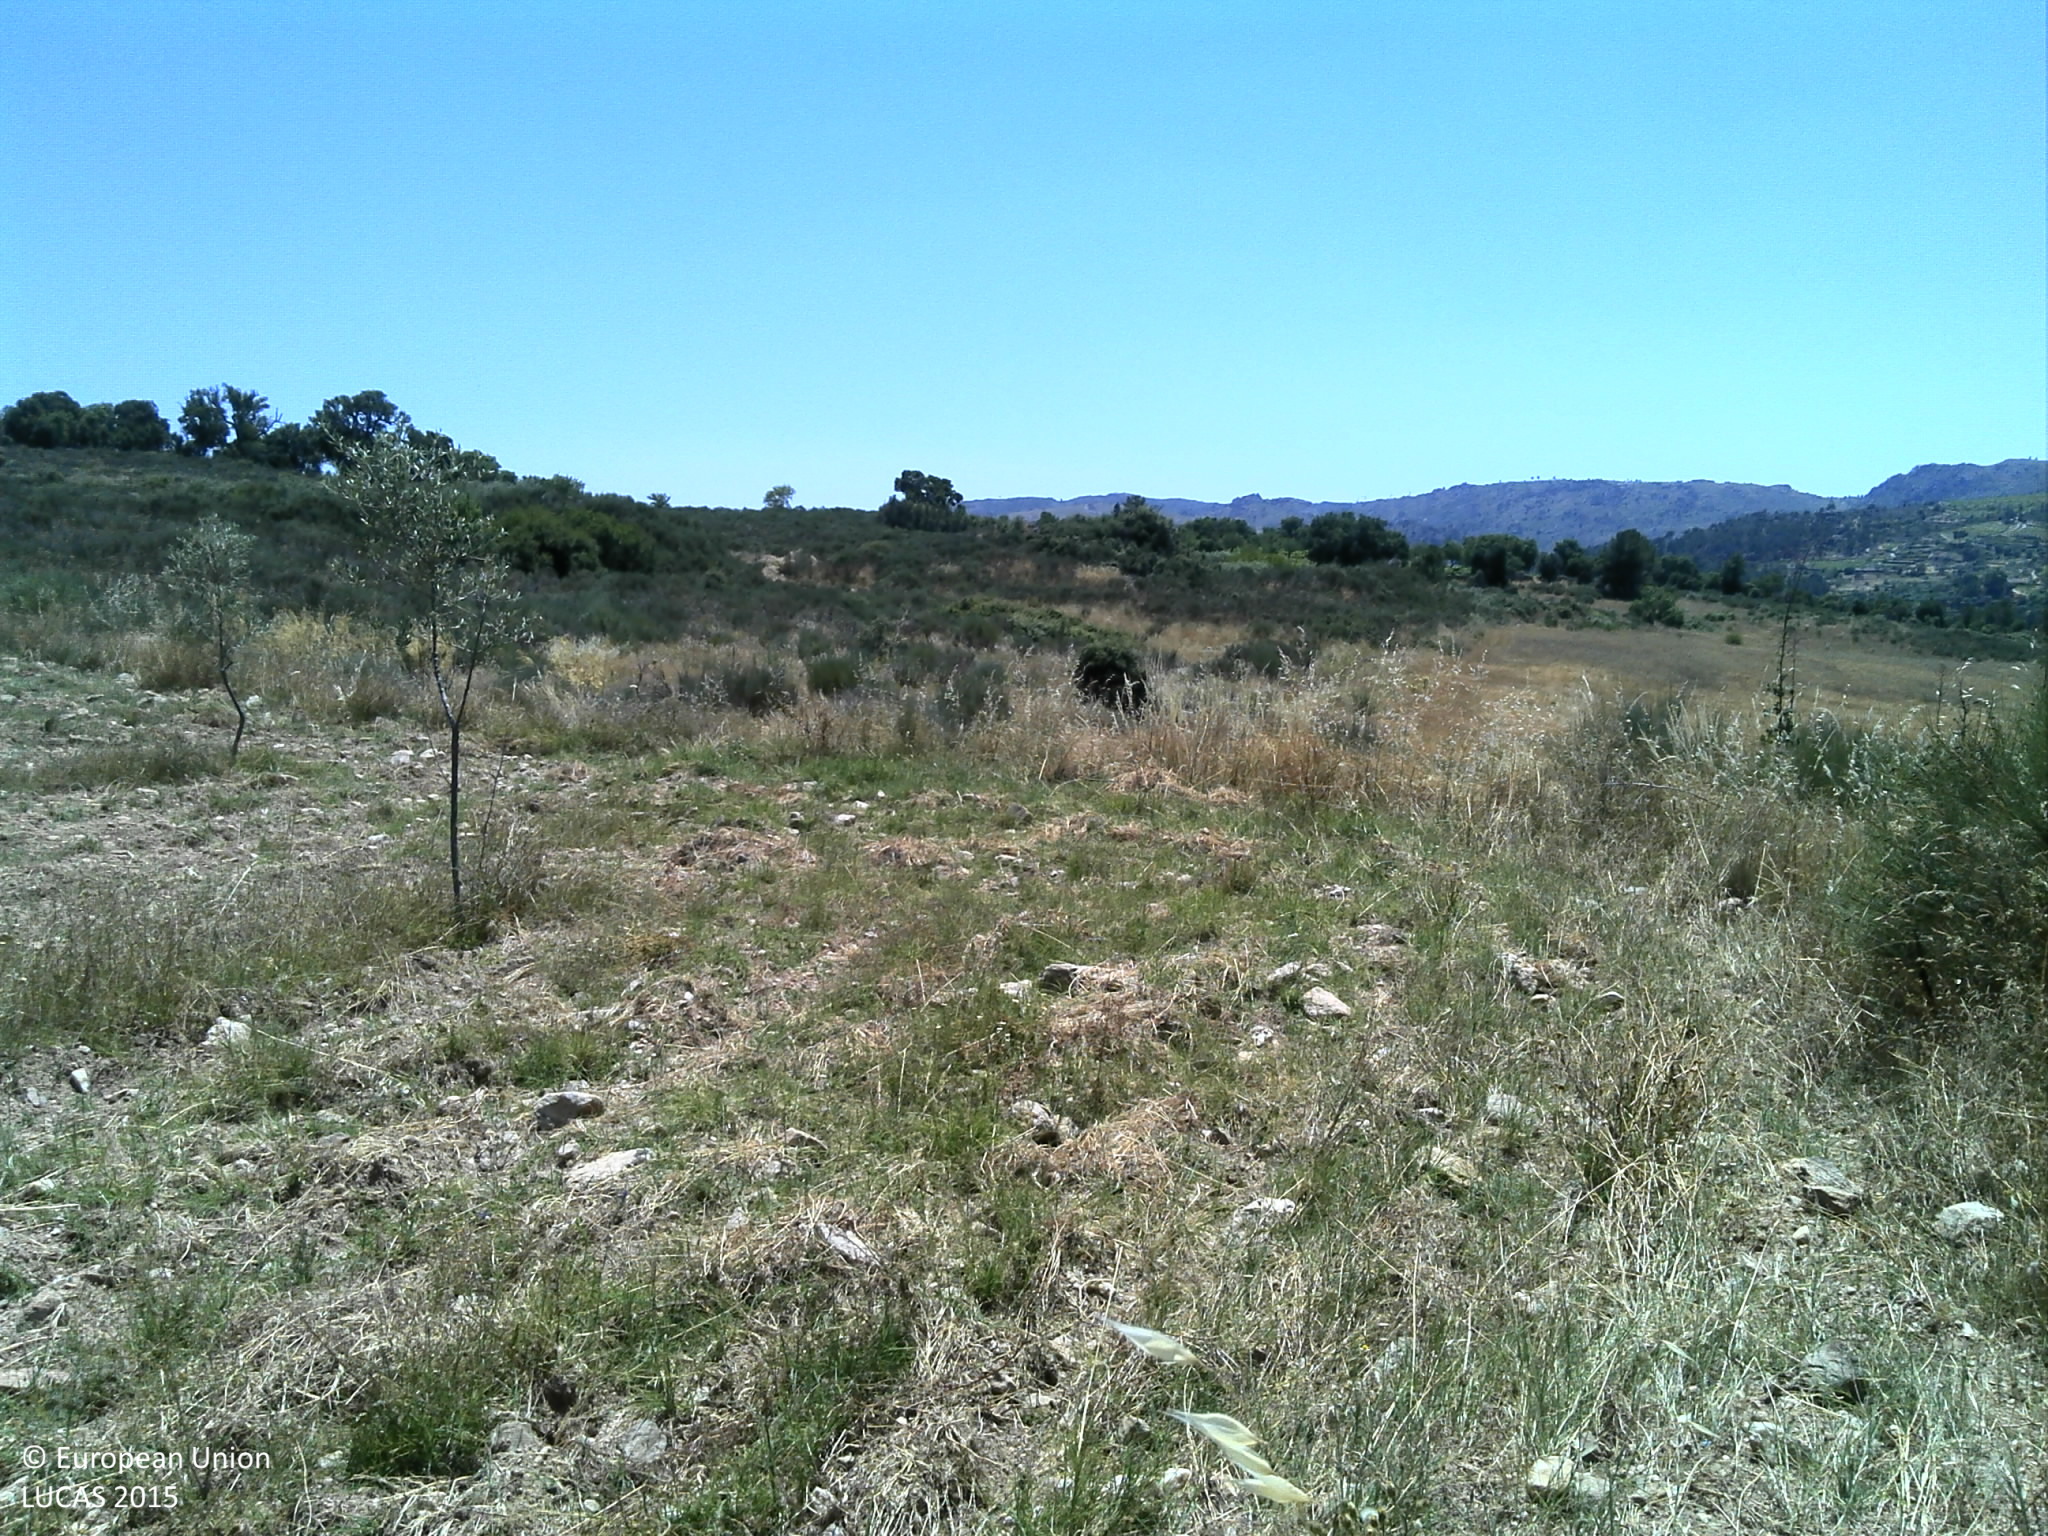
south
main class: Cropland
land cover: Olive groves
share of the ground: 10 - 25 %
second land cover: Grassland without tree/shrub cover
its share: 10 - 25 %
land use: Agriculture (excluding fallow land and kitchen gardens)
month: June
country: PT
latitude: 40.9177
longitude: -7.2697
